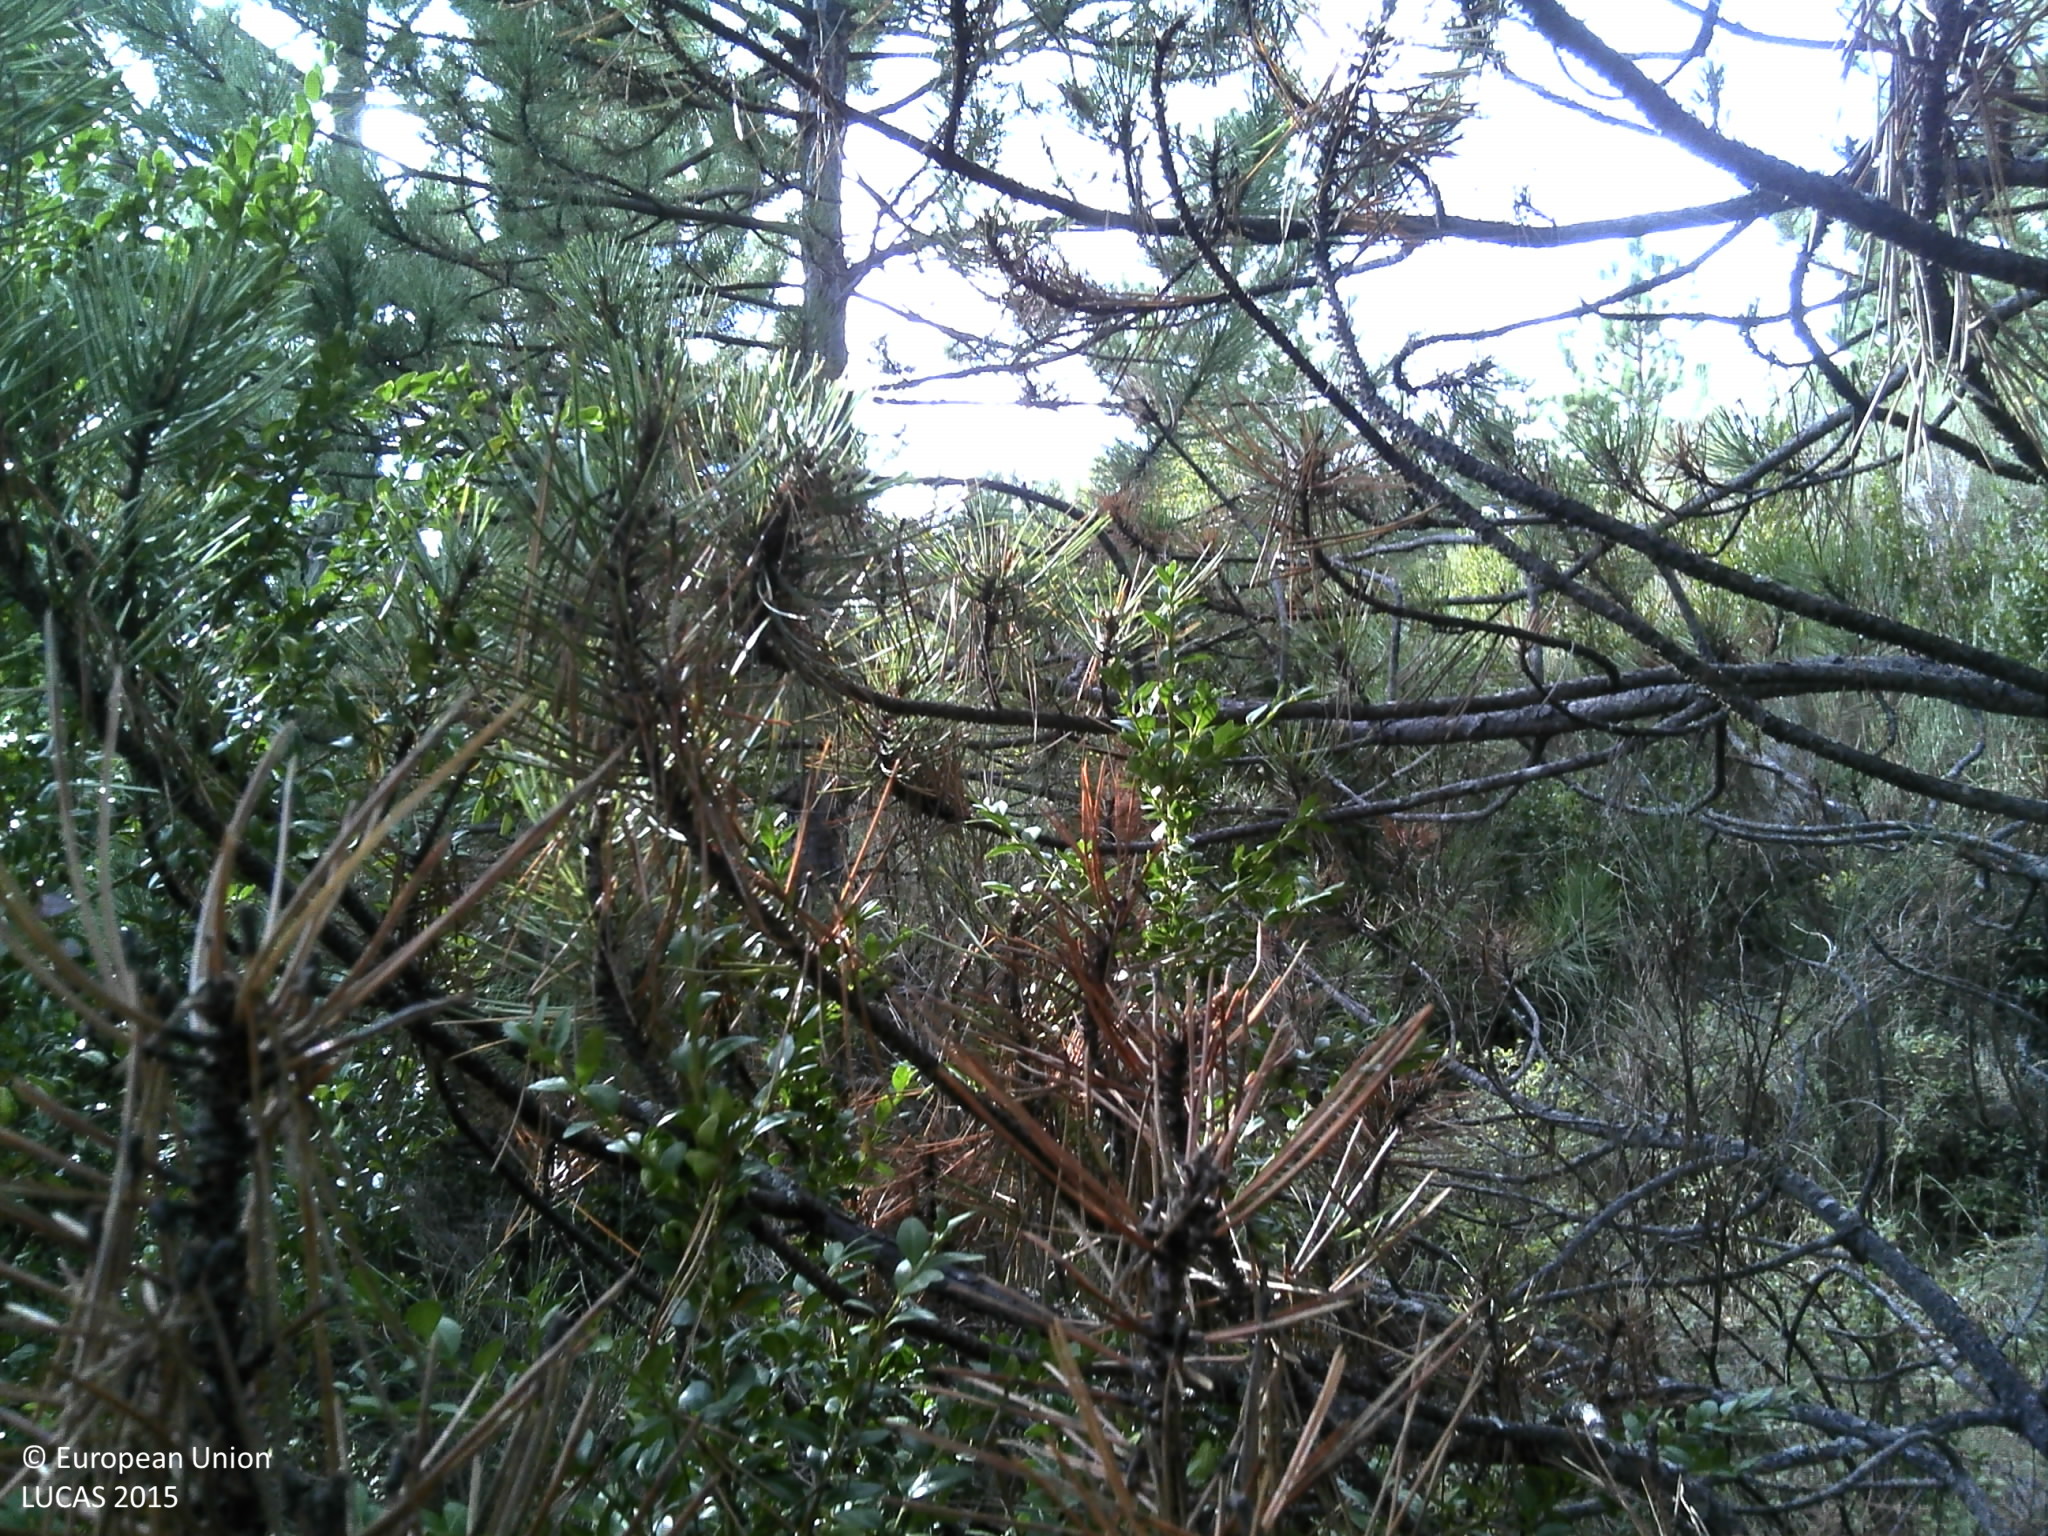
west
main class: Woodland
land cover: Pine dominated coniferous woodland
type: alpine coniferous forest
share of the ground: > 75 %
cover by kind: coniferous forest trees 70 %, shrubs 20 %, herbaceous plants 10 %
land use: Forestry
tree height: > 5 m
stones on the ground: < 10 %
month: September
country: FR
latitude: 43.7710
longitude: 6.5914
